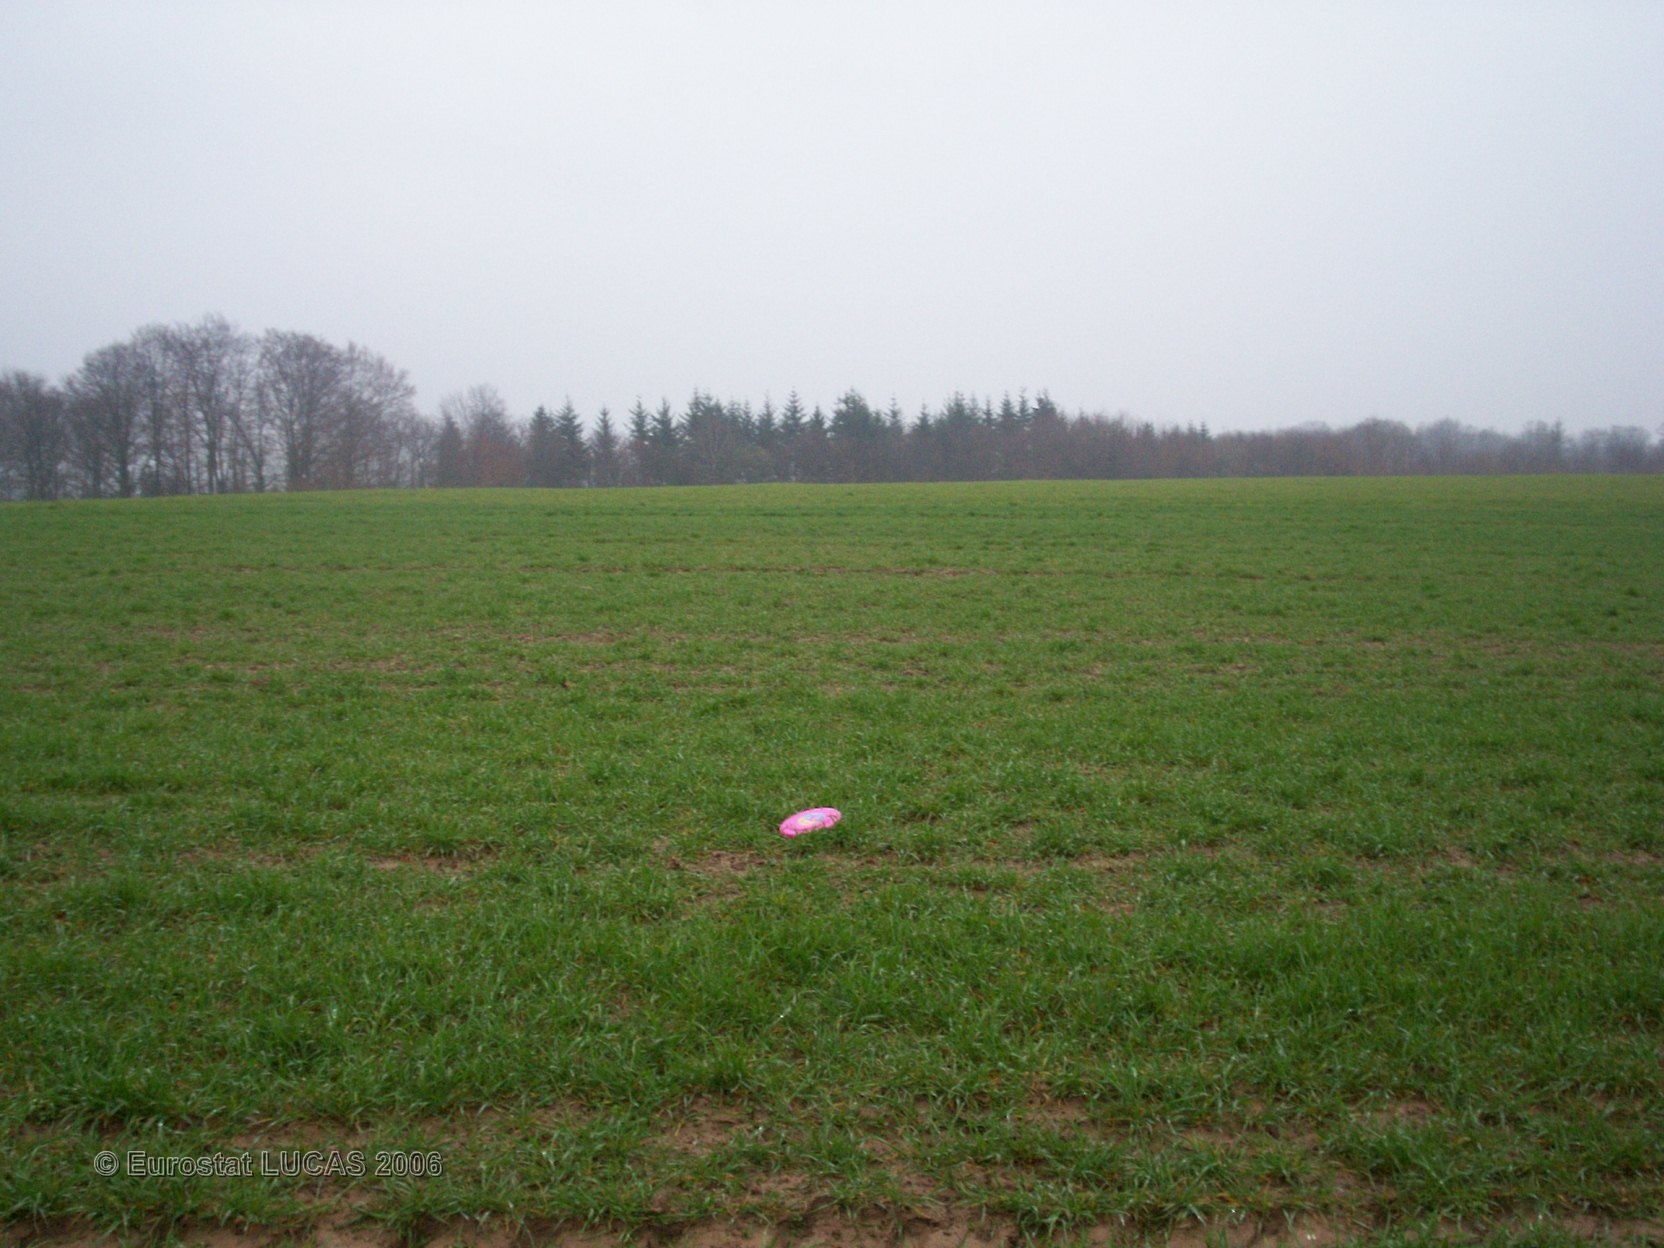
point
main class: Cropland
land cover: Common wheat
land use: Agriculture (excluding fallow land and kitchen gardens)
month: April
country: FR
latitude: 48.1238
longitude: 6.2524
